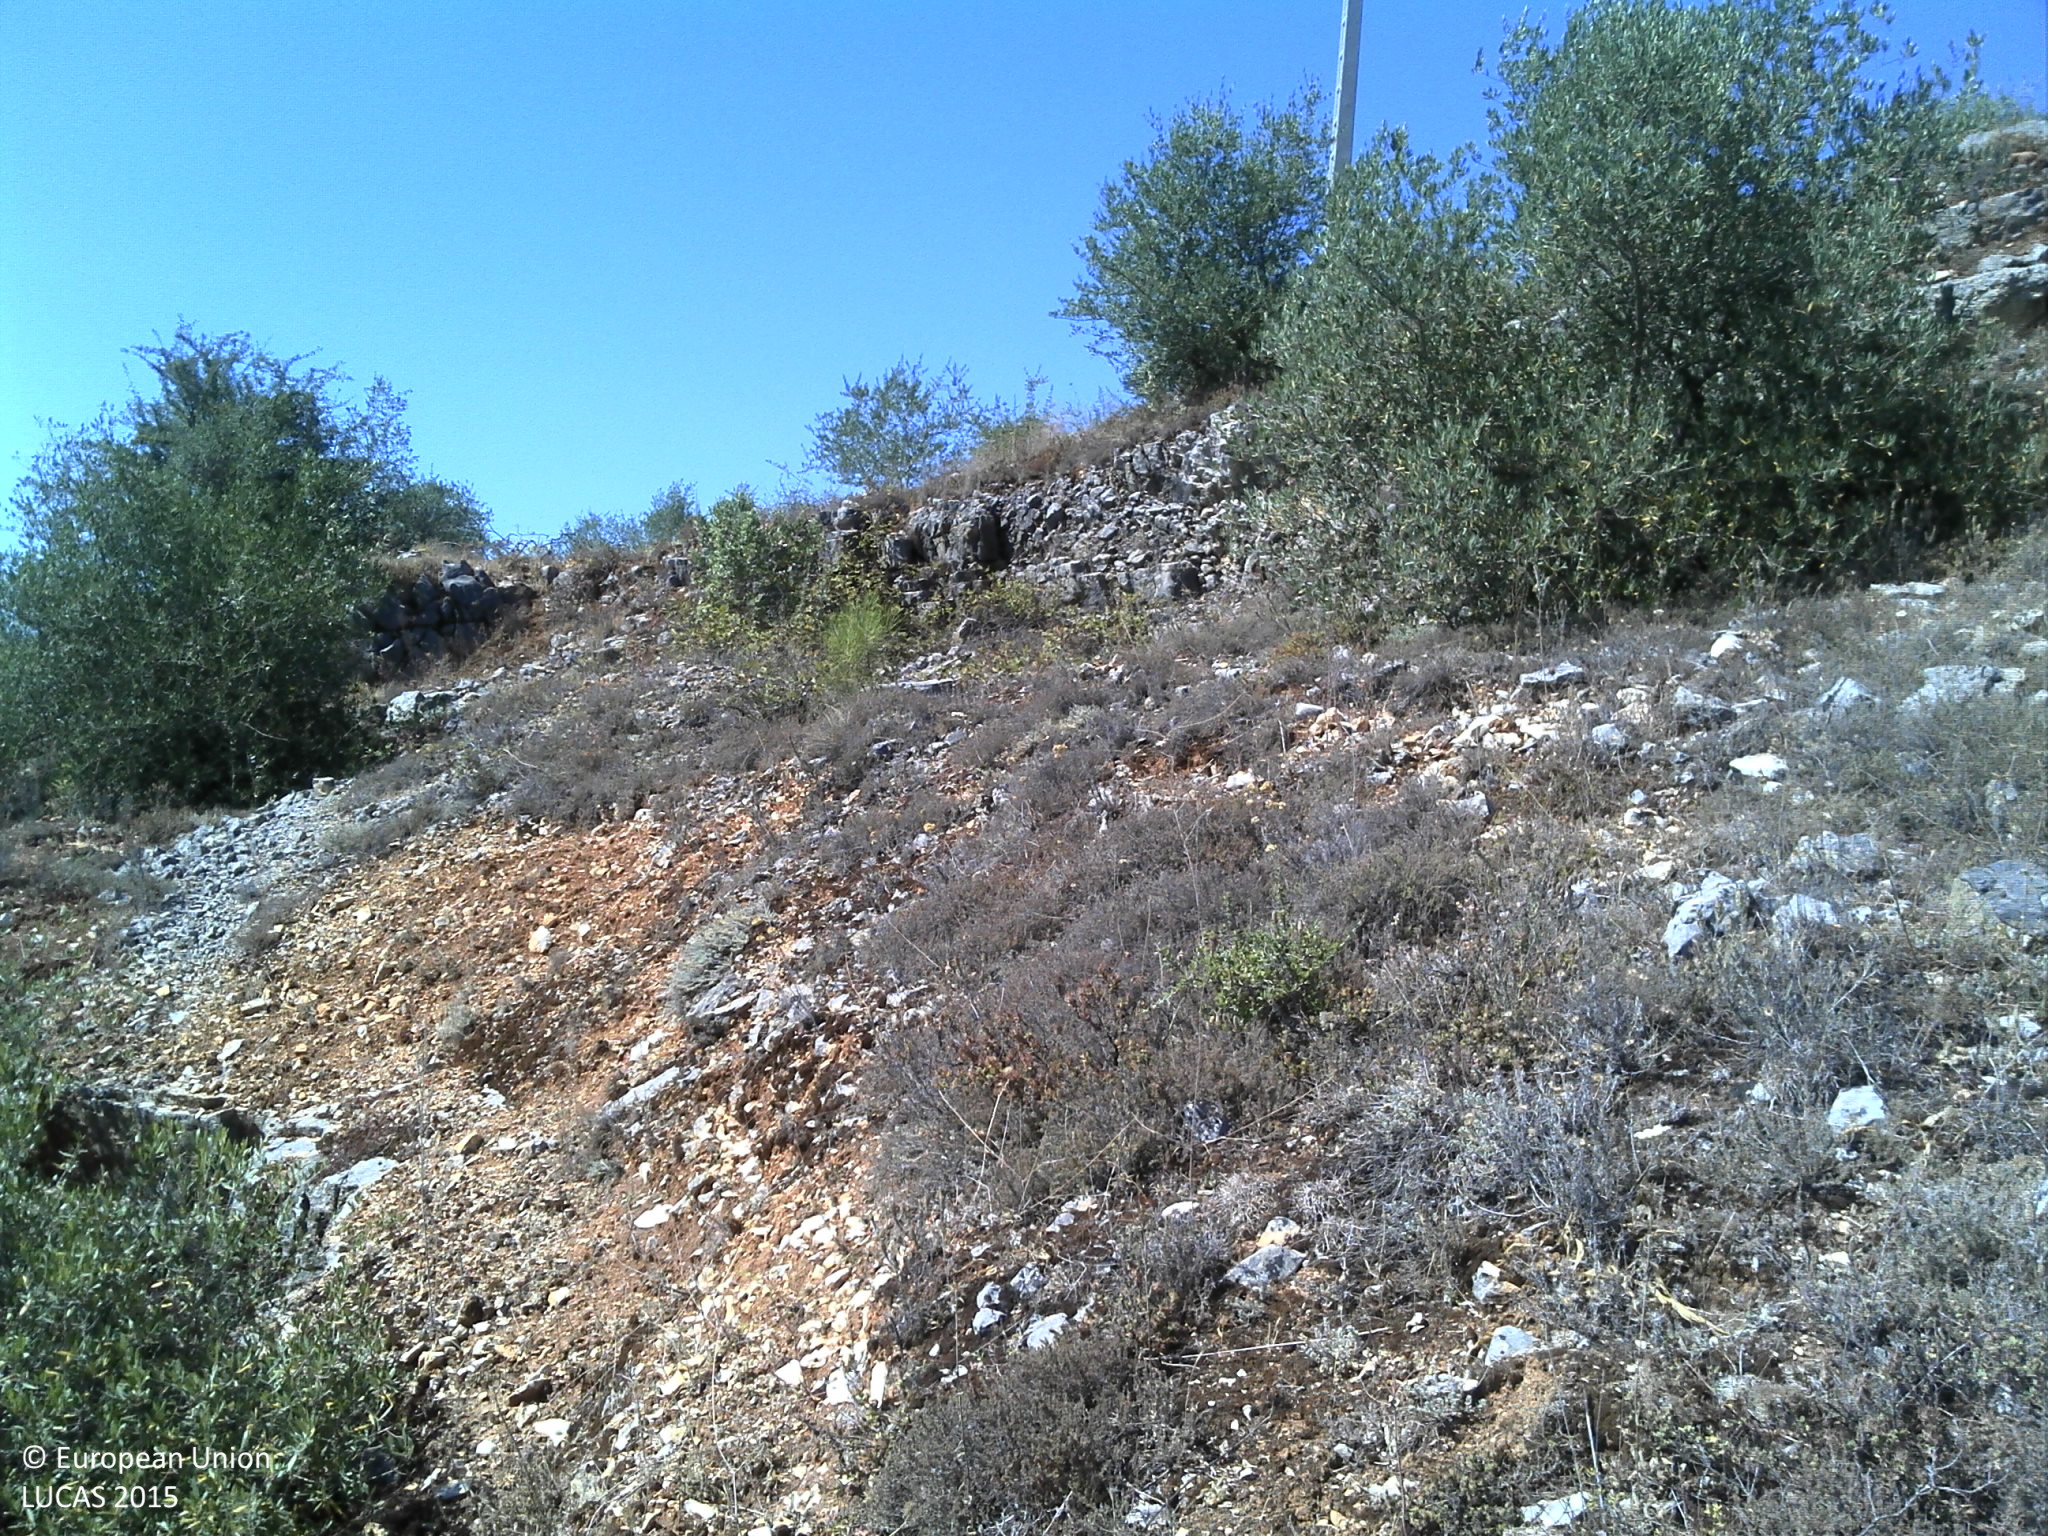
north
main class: Grassland
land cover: Grassland with sparse tree/shrub cover
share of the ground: 25 - 50 %
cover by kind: herbaceous plants 50 %, unconsolidated bare surface 25 %, broadleaved forest trees 5 %
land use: Abandoned areas
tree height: < 5 m
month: July
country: PT
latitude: 40.0190
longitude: -8.5367
